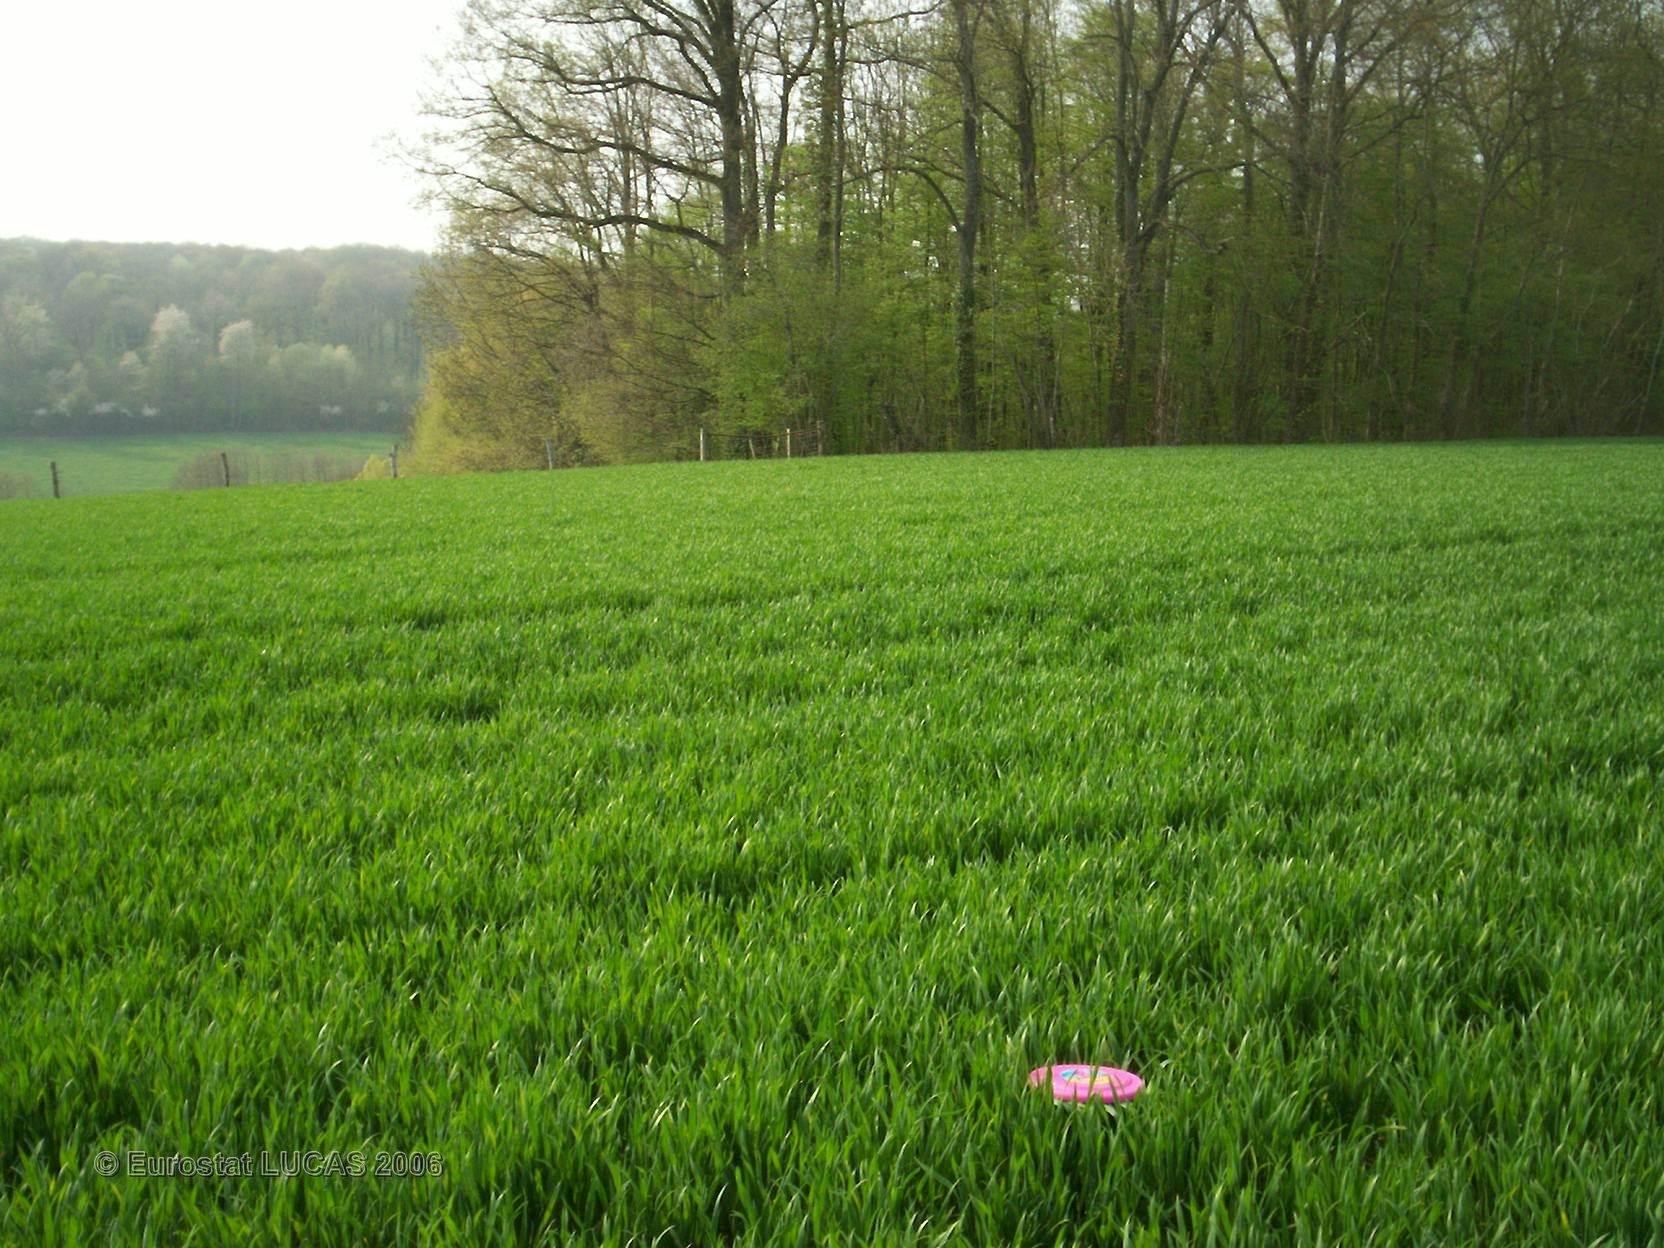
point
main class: Cropland
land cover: Common wheat
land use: Agriculture (excluding fallow land and kitchen gardens)
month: April
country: FR
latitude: 49.5499
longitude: 4.5643
